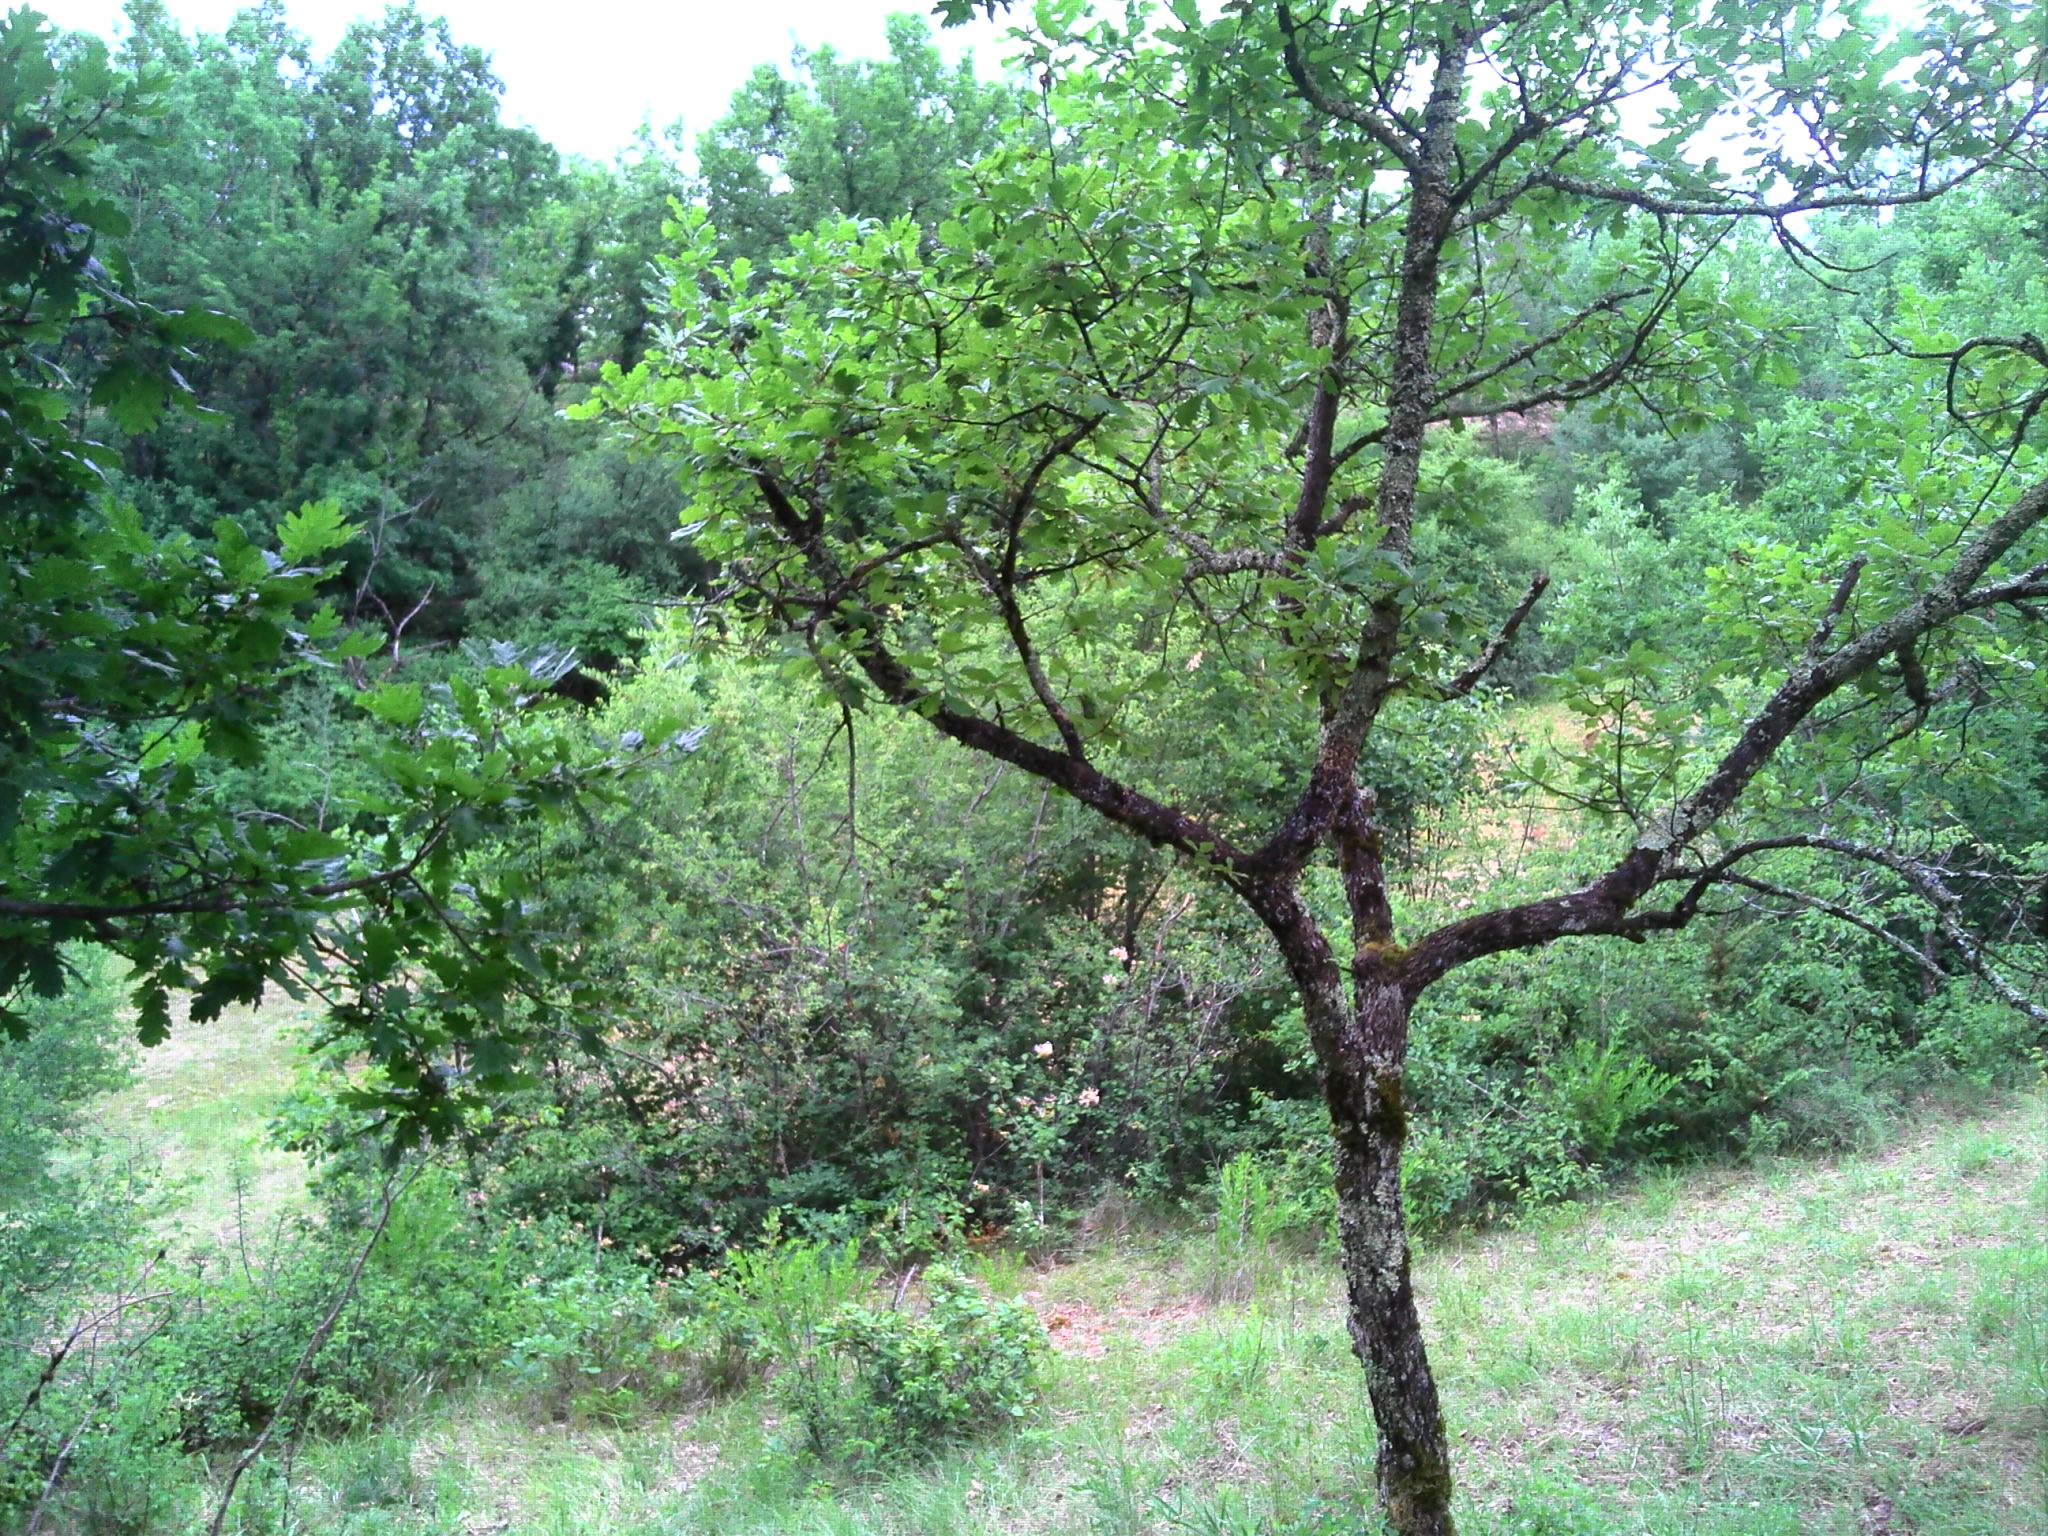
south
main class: Woodland
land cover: Broadleaved woodland
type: thermophilous deciduous forest
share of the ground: 50 - 75 %
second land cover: Grassland without tree/shrub cover
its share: 25 - 50 %
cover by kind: broadleaved forest trees 80 %, herbaceous plants 20 %
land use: Forestry
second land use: Agriculture (excluding fallow land and kitchen gardens)
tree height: > 5 m
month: June
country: FR
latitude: 44.4280
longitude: 1.8478
